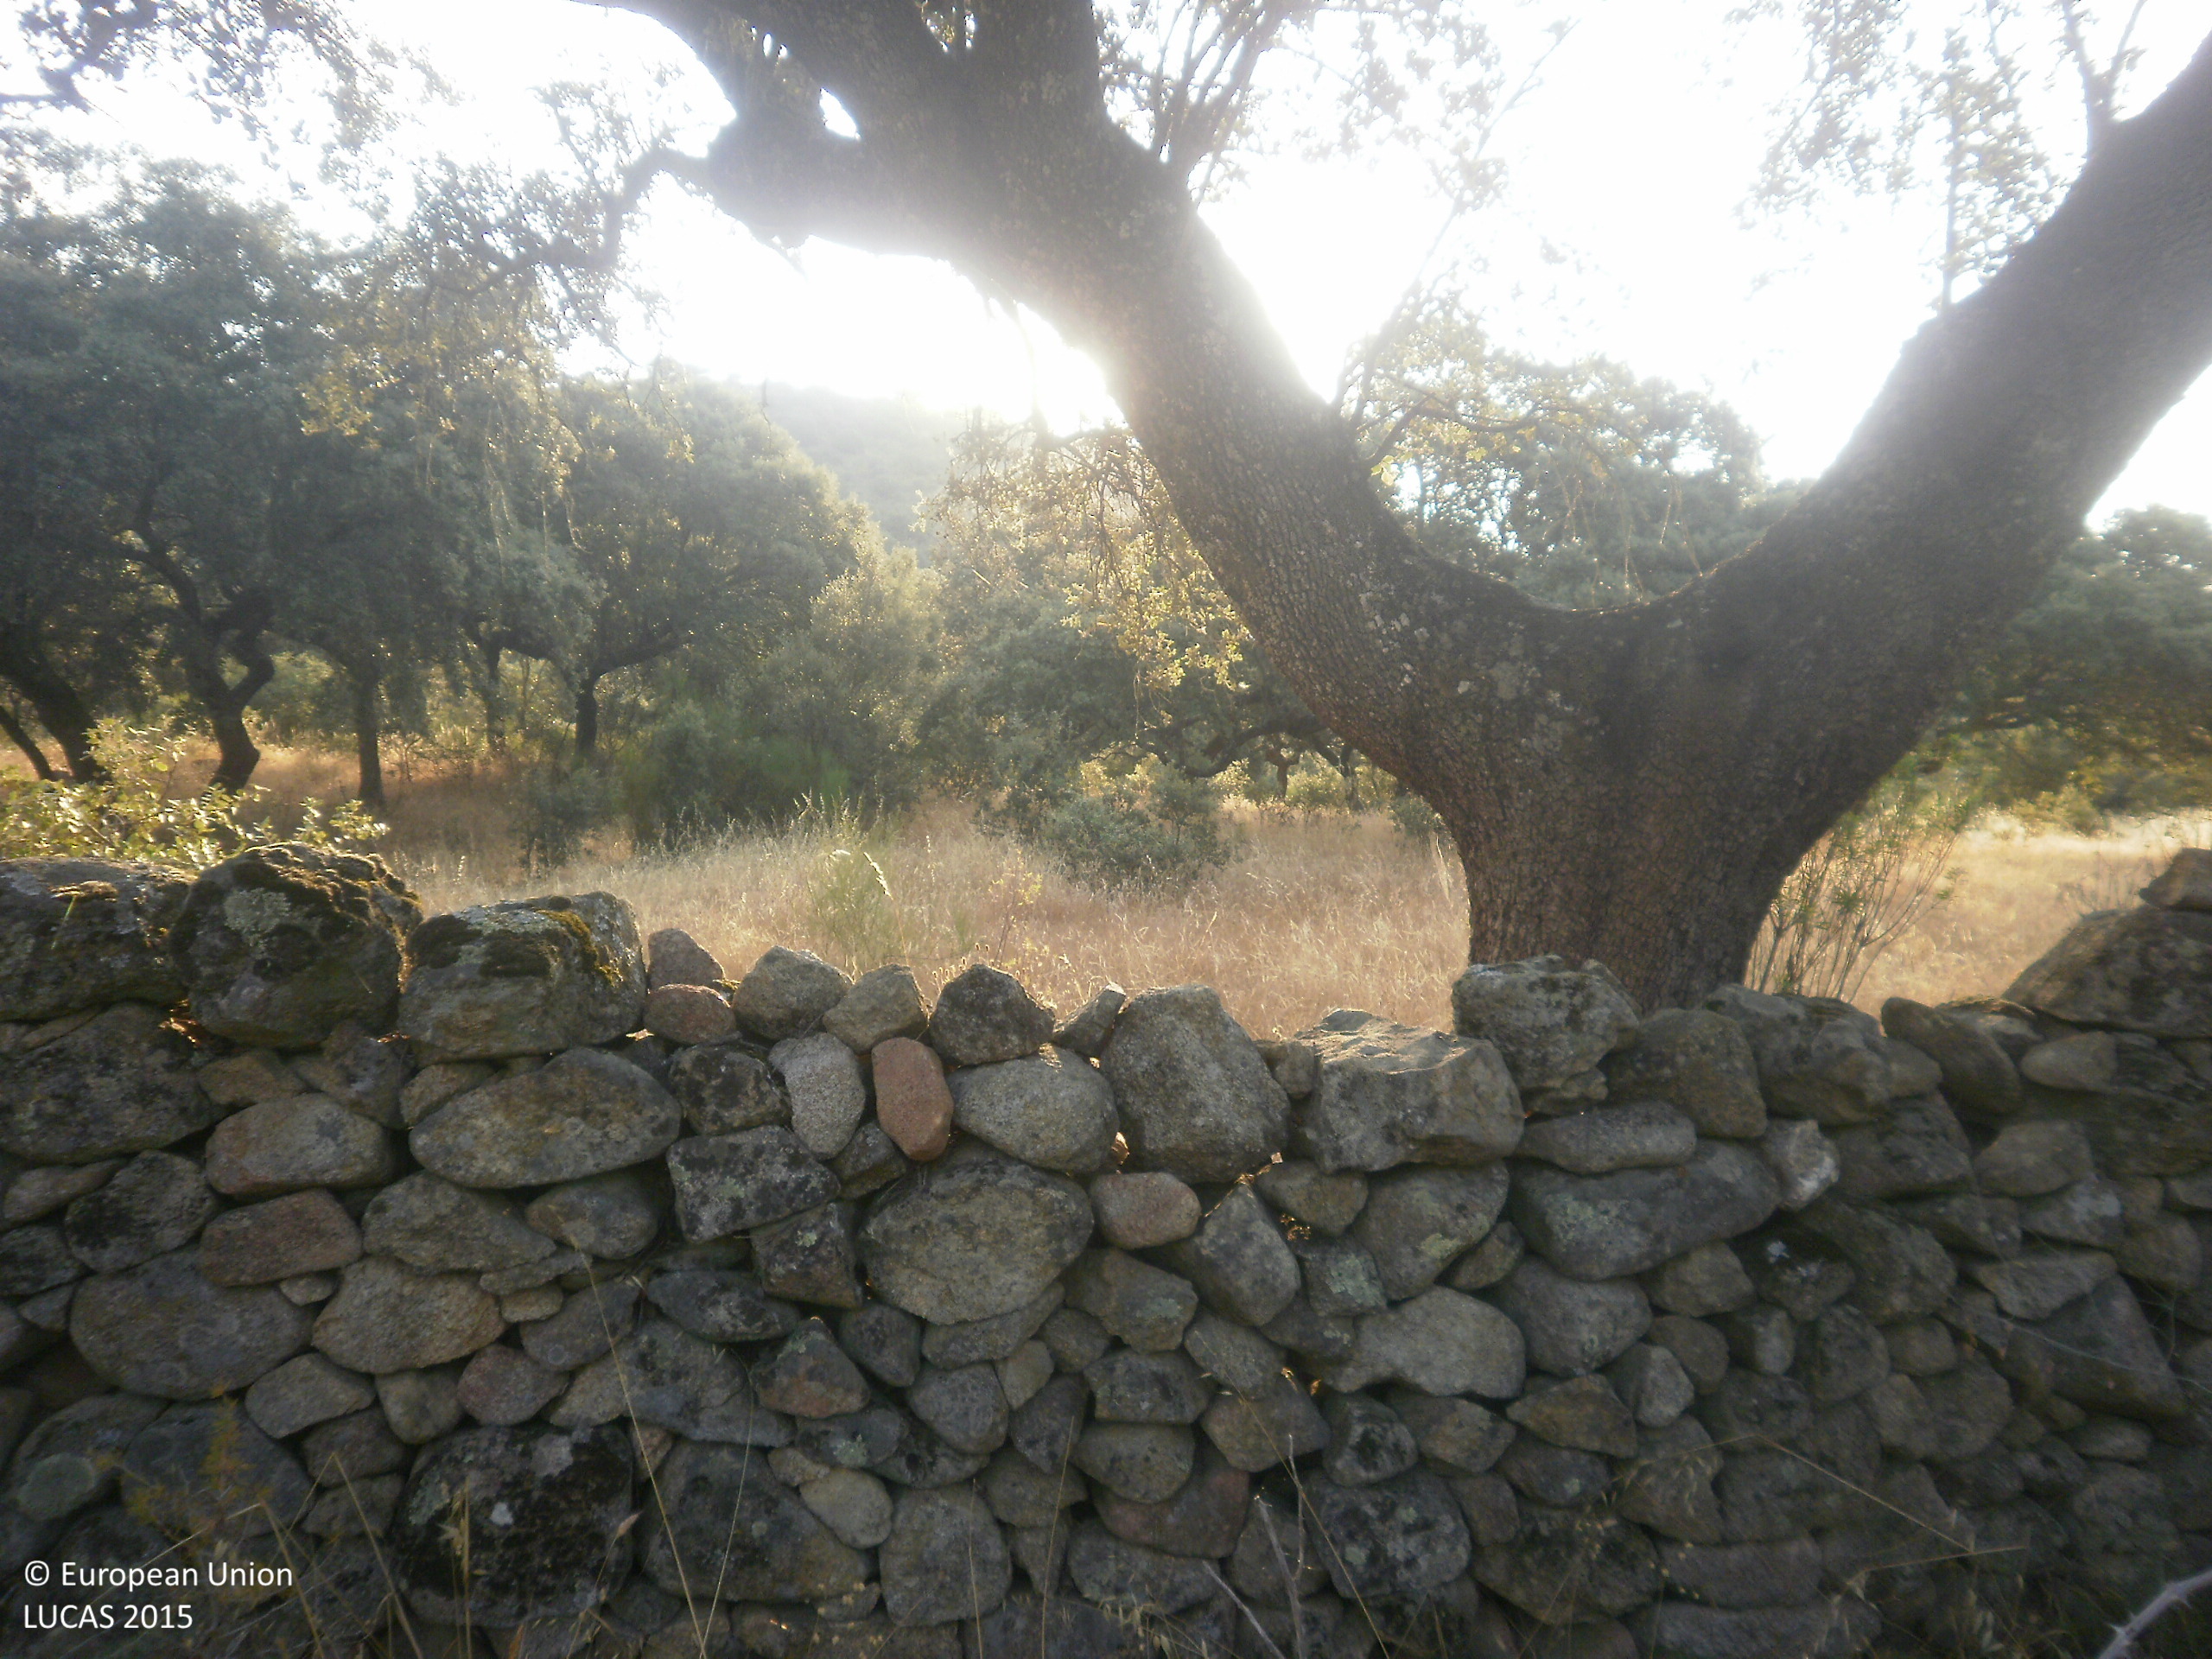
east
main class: Woodland
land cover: Broadleaved woodland
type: broadleaved evergreen forest
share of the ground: 50 - 75 %
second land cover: Grassland without tree/shrub cover
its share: 50 - 75 %
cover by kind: herbaceous plants 70 %, broadleaved forest trees 20 %, shrubs 10 %
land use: Forestry
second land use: Agriculture (excluding fallow land and kitchen gardens)
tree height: > 5 m
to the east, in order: Broadleaved woodland; Grassland without tree/shrub cover; Broadleaved woodland; Shrubland without tree cover; Dry stone walls; Broadleaved woodland
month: June
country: ES
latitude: 39.2665
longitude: -5.9464
